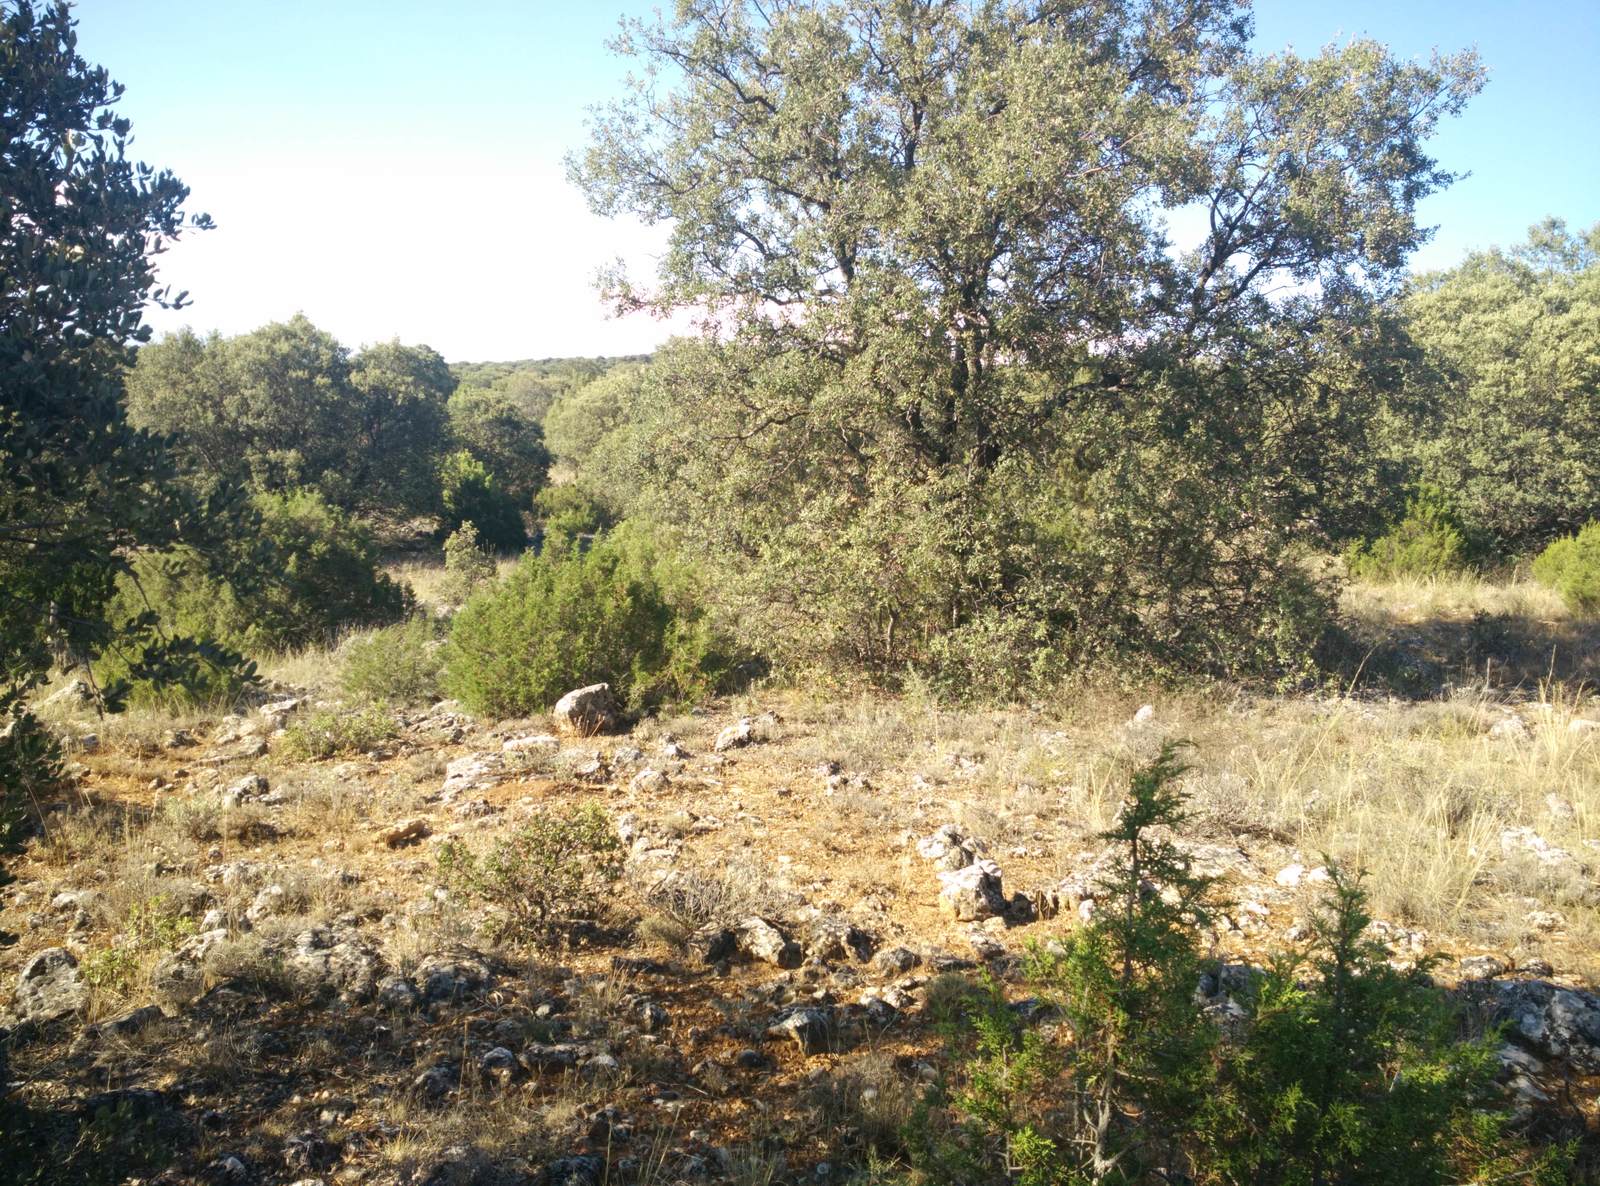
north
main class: Woodland
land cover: Broadleaved woodland
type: thermophilous deciduous forest
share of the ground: 50 - 75 %
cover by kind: broadleaved forest trees 50 %, unconsolidated bare surface 30 %, shrubs 20 %
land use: Semi-natural and natural areas not in use
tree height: > 5 m
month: July
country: ES
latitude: 40.9757
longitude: -2.6885
